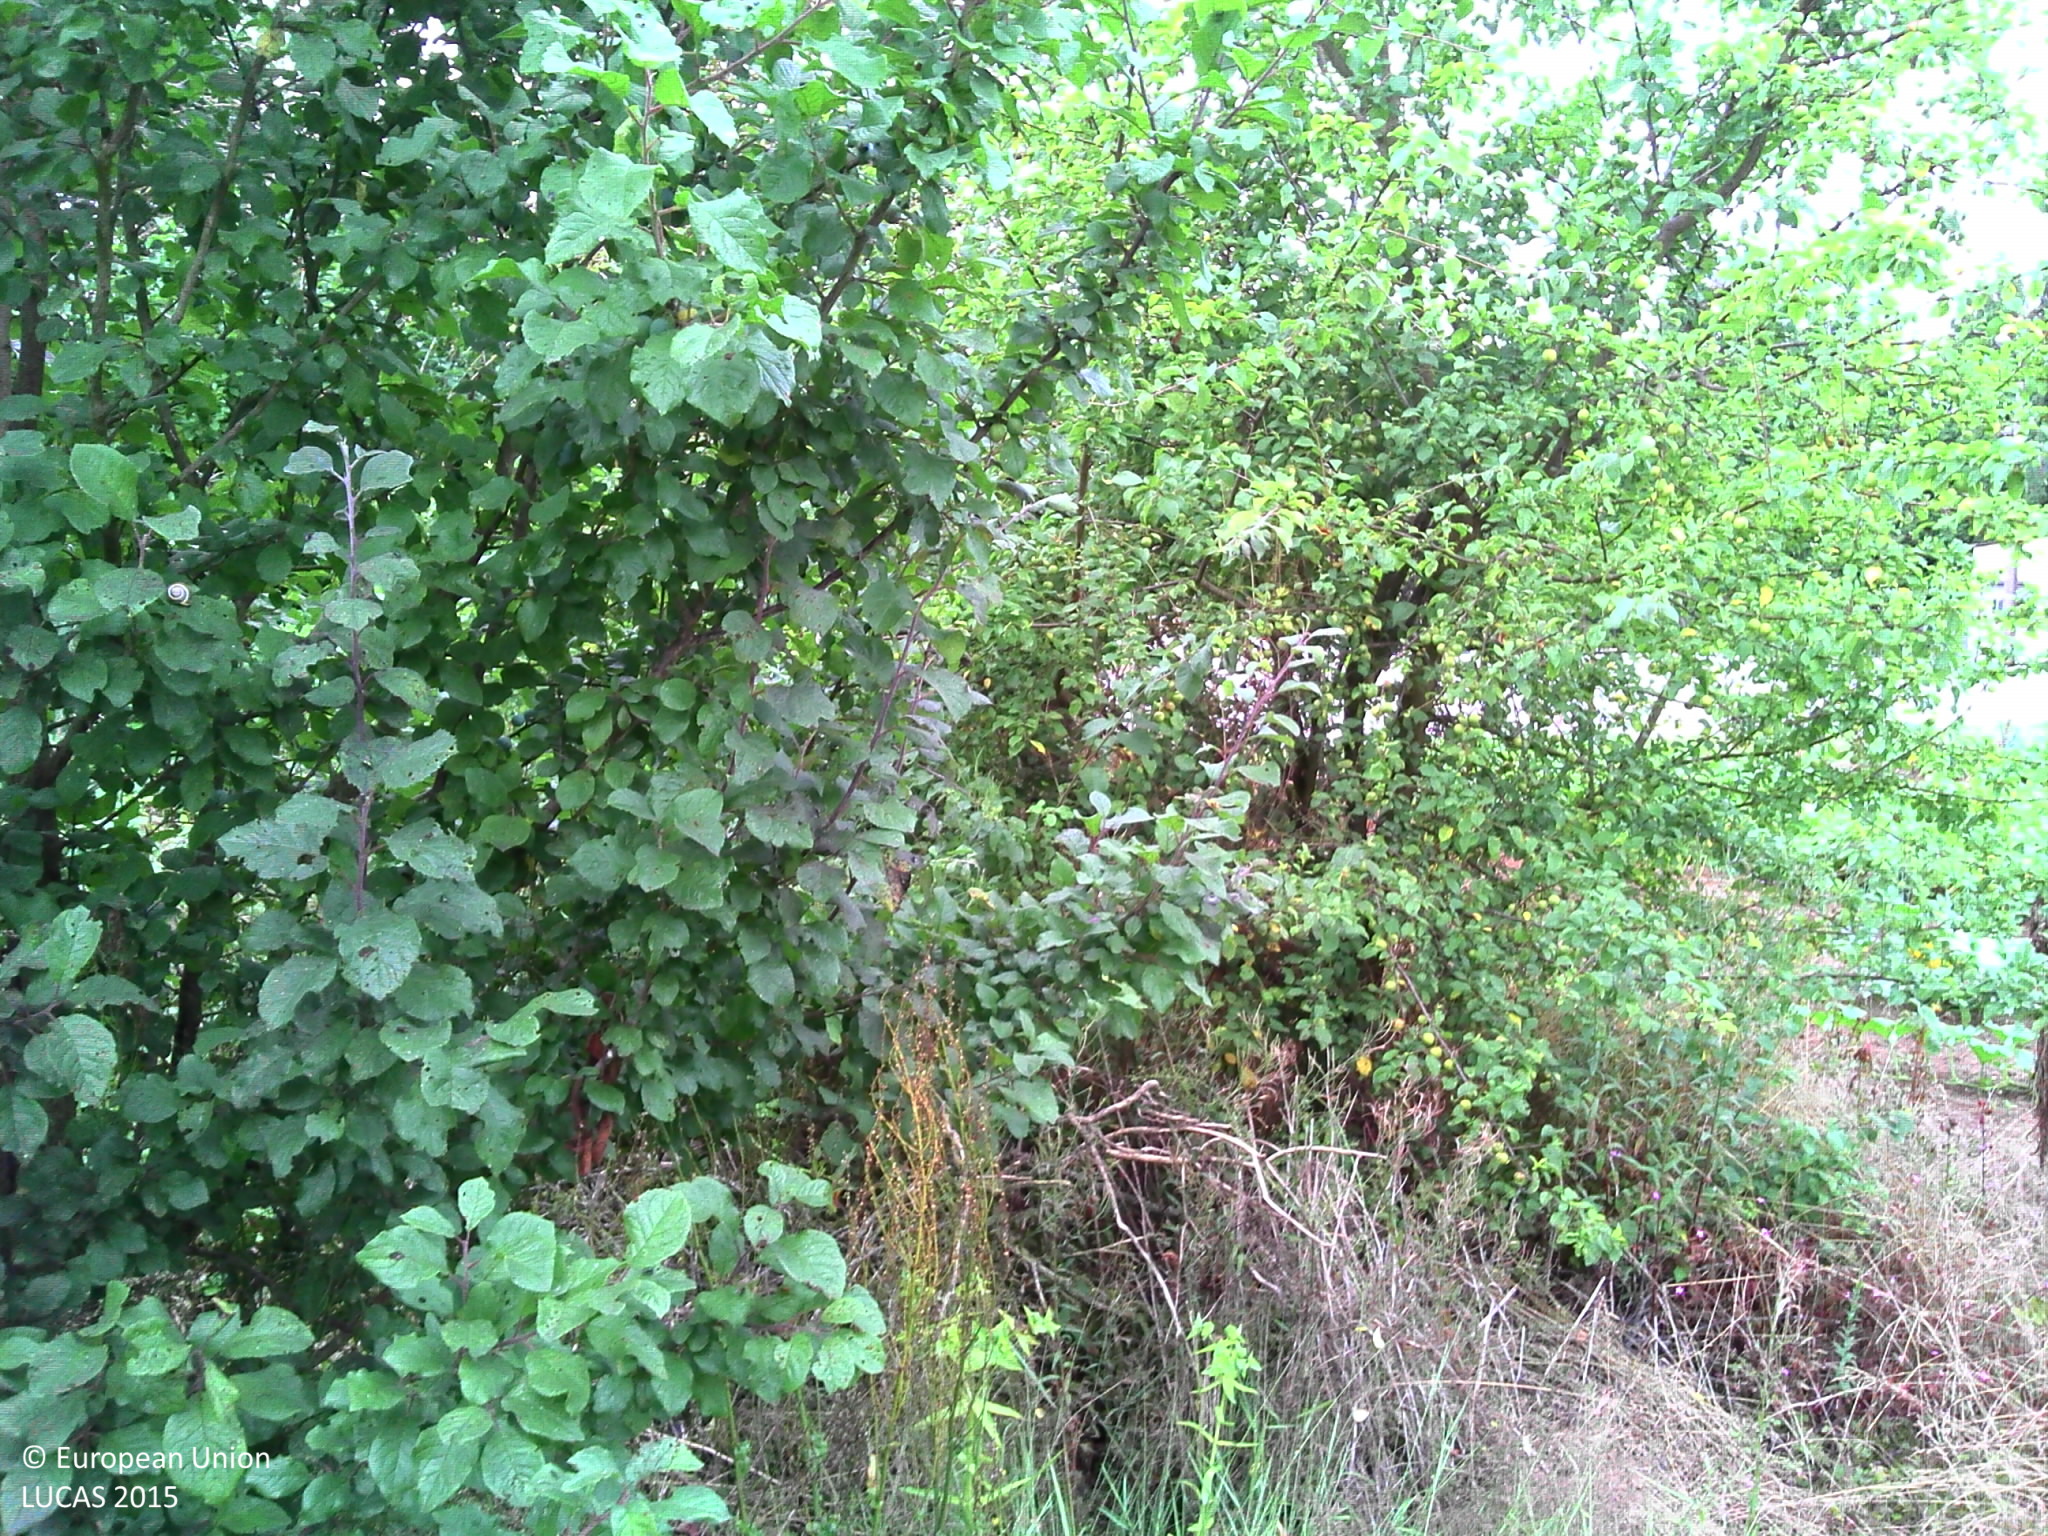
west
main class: Grassland
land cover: Grassland without tree/shrub cover
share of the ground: > 75 %
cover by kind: herbaceous plants 95 %
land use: Residential
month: July
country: FR
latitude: 50.1895
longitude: 2.4940
